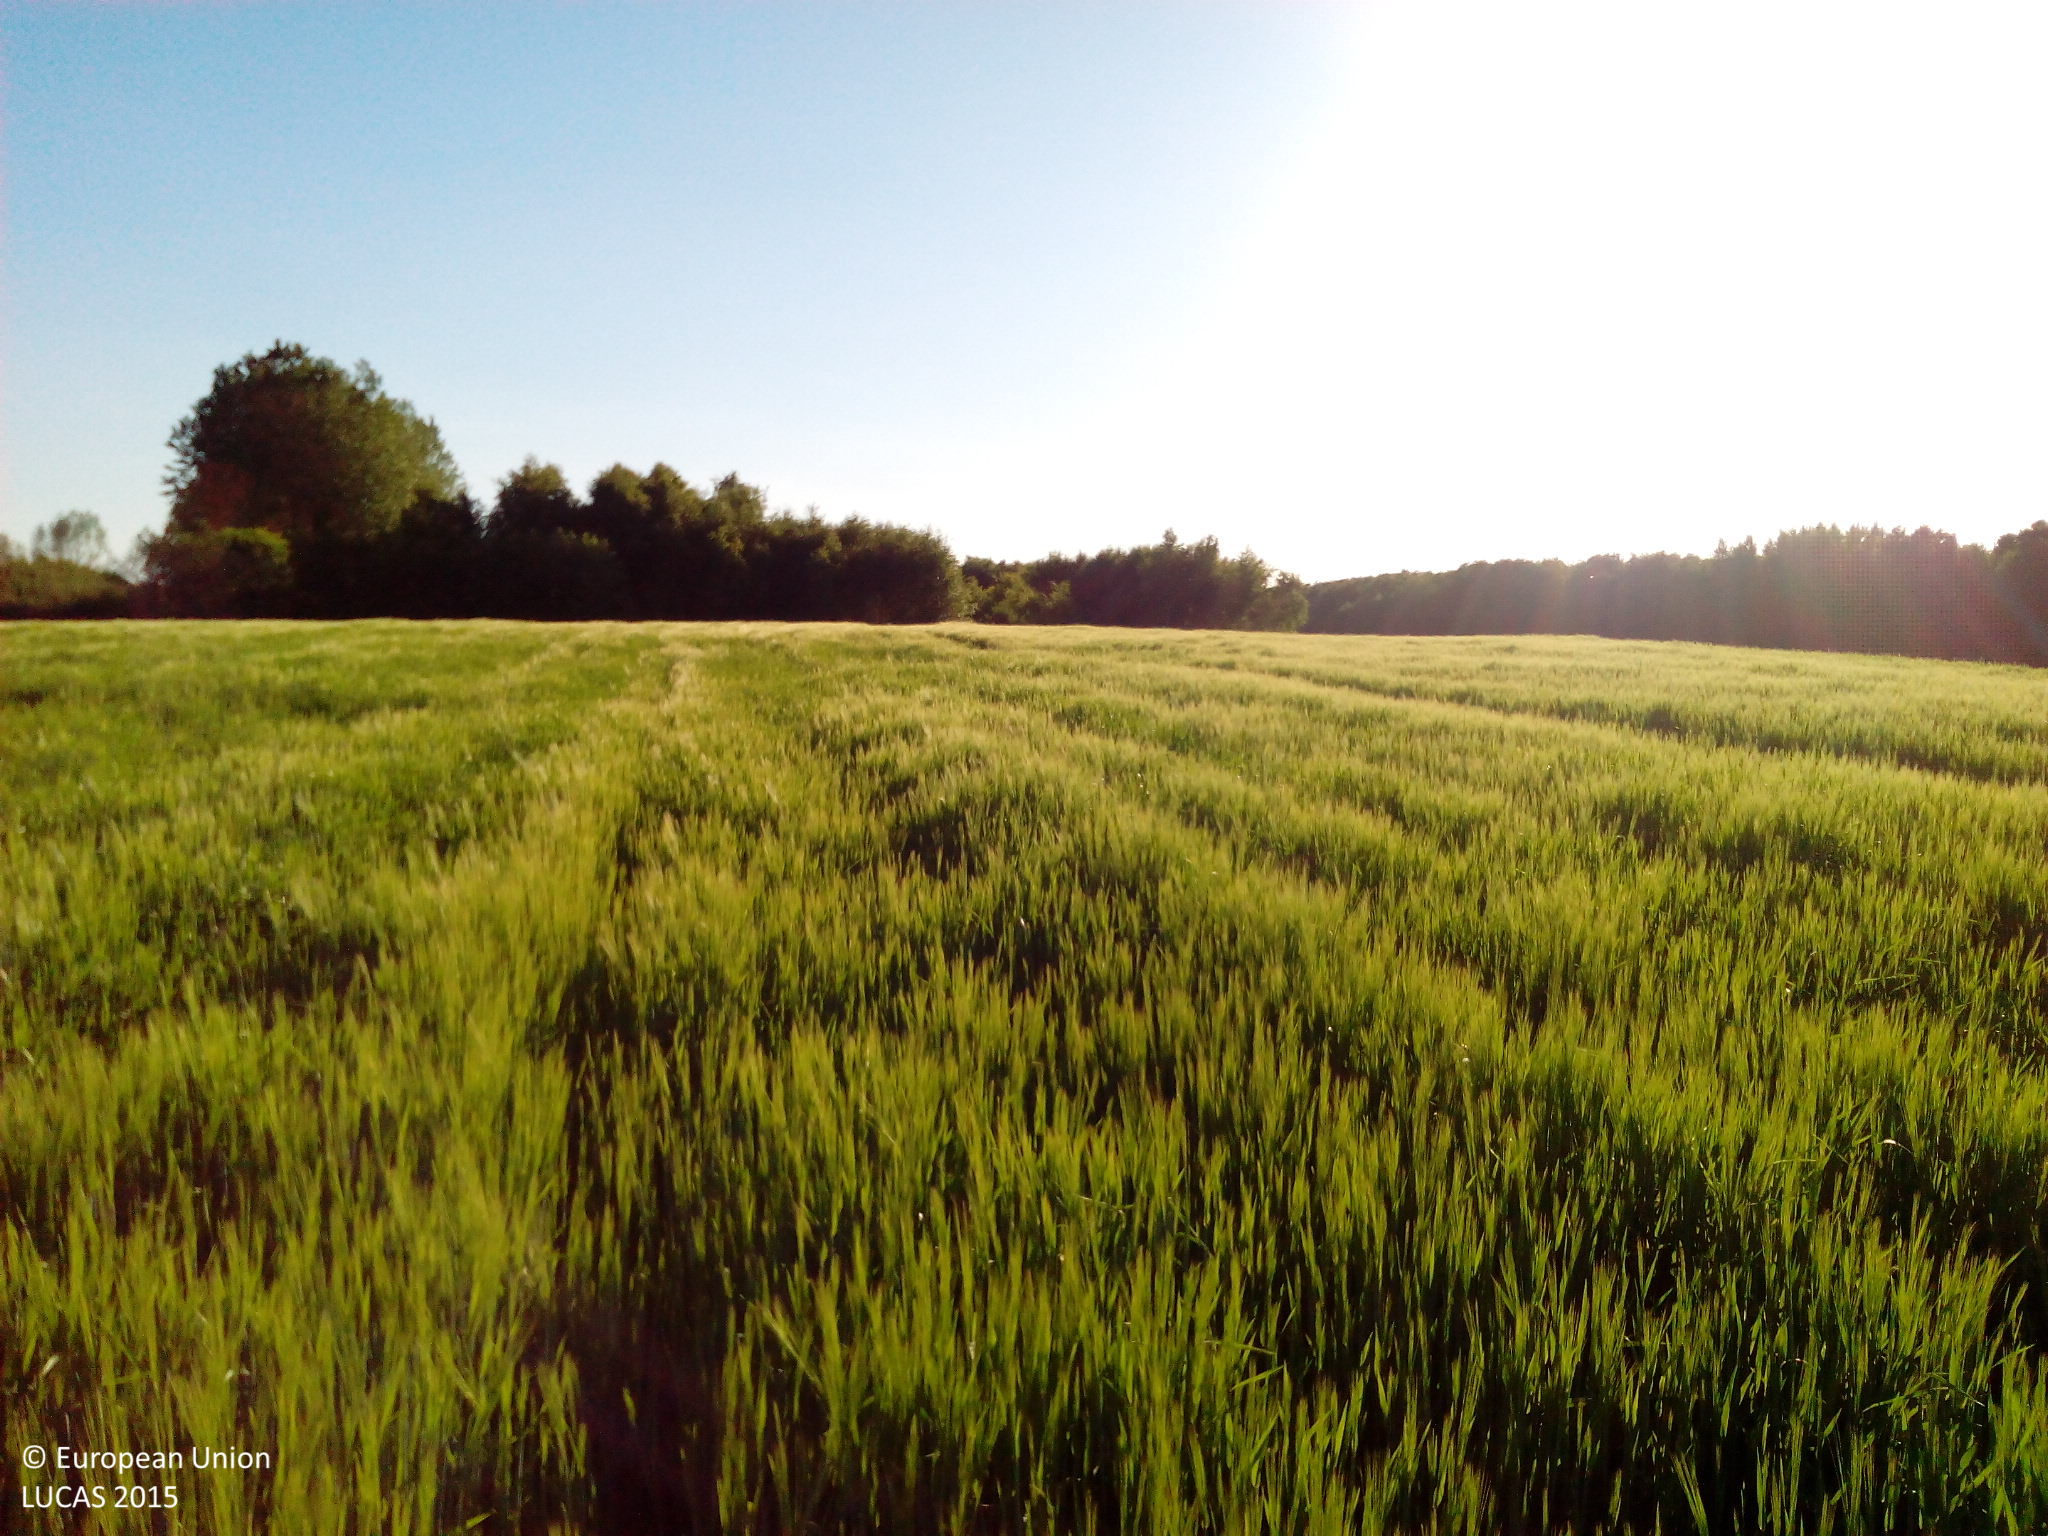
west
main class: Cropland
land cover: Triticale
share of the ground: > 75 %
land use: Agriculture (excluding fallow land and kitchen gardens)
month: June
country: DK
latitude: 56.3473
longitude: 10.7595
